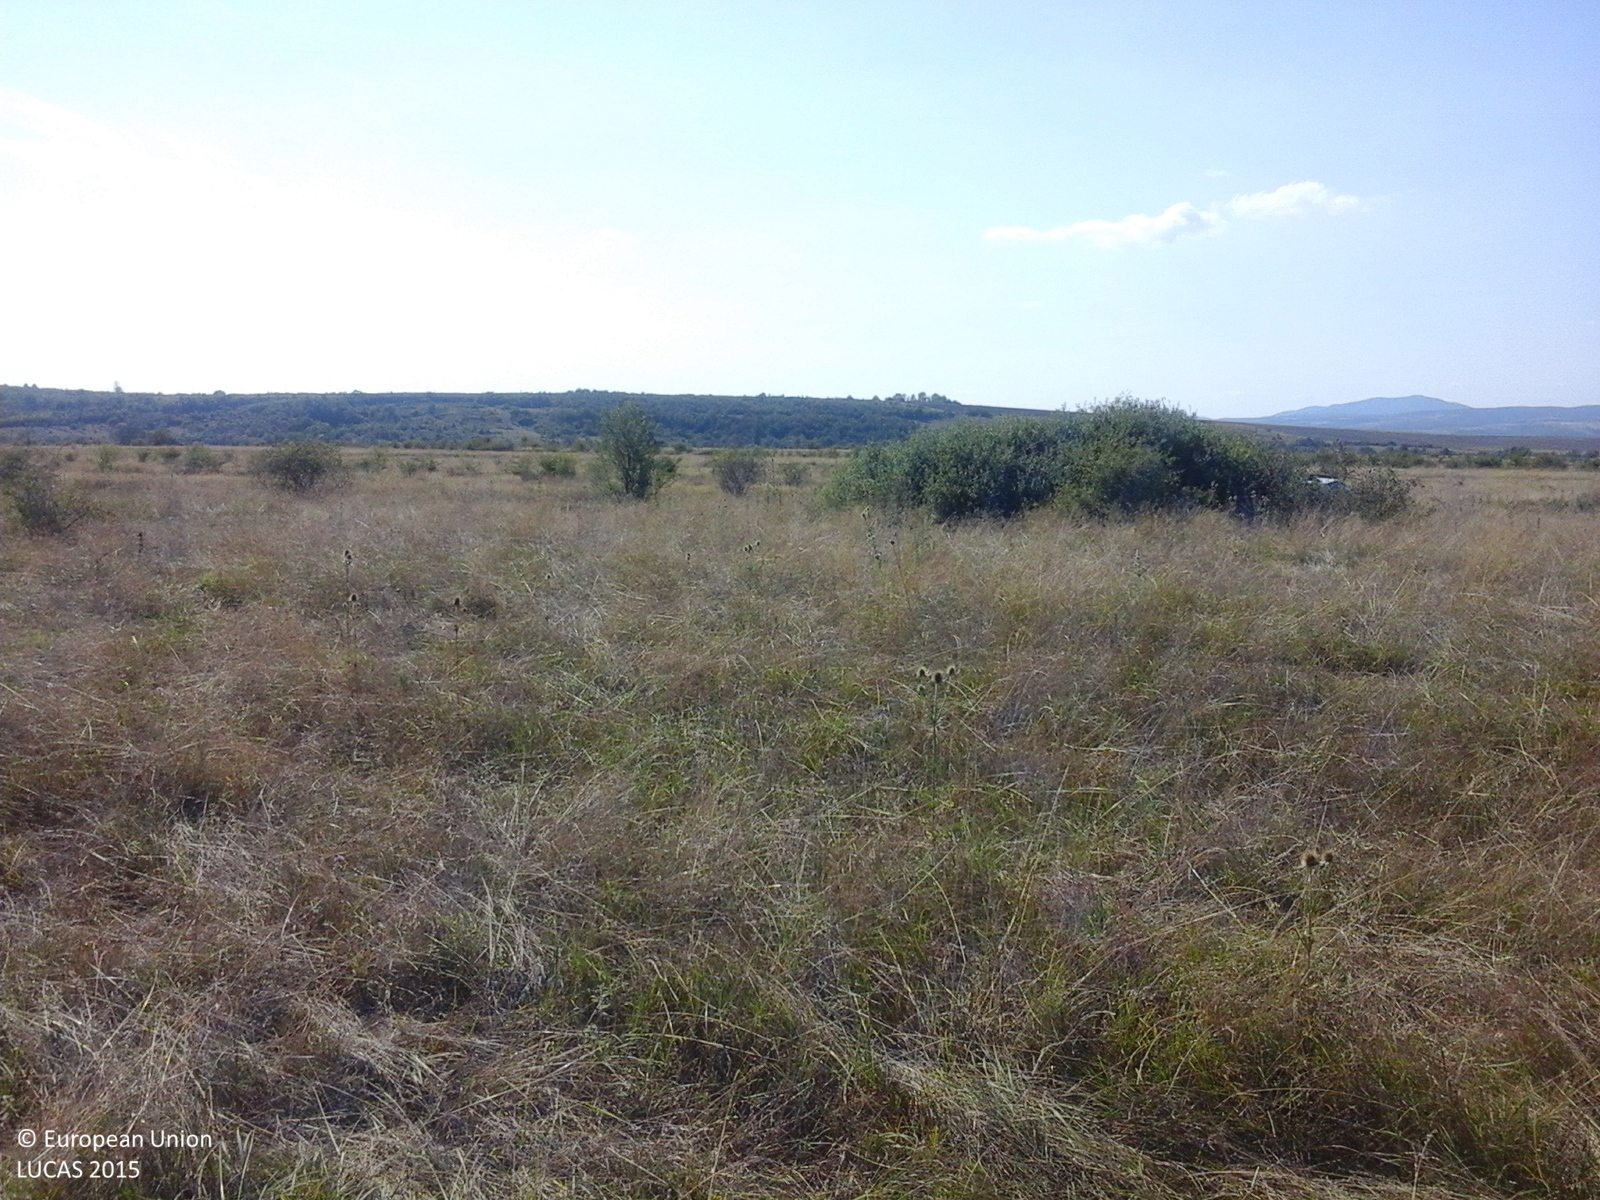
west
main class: Grassland
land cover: Grassland with sparse tree/shrub cover
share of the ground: > 75 %
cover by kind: herbaceous plants 85 %, shrubs 10 %, broadleaved forest trees 5 %
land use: Residential
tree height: < 5 m
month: August
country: RO
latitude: 45.0572
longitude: 21.6504
